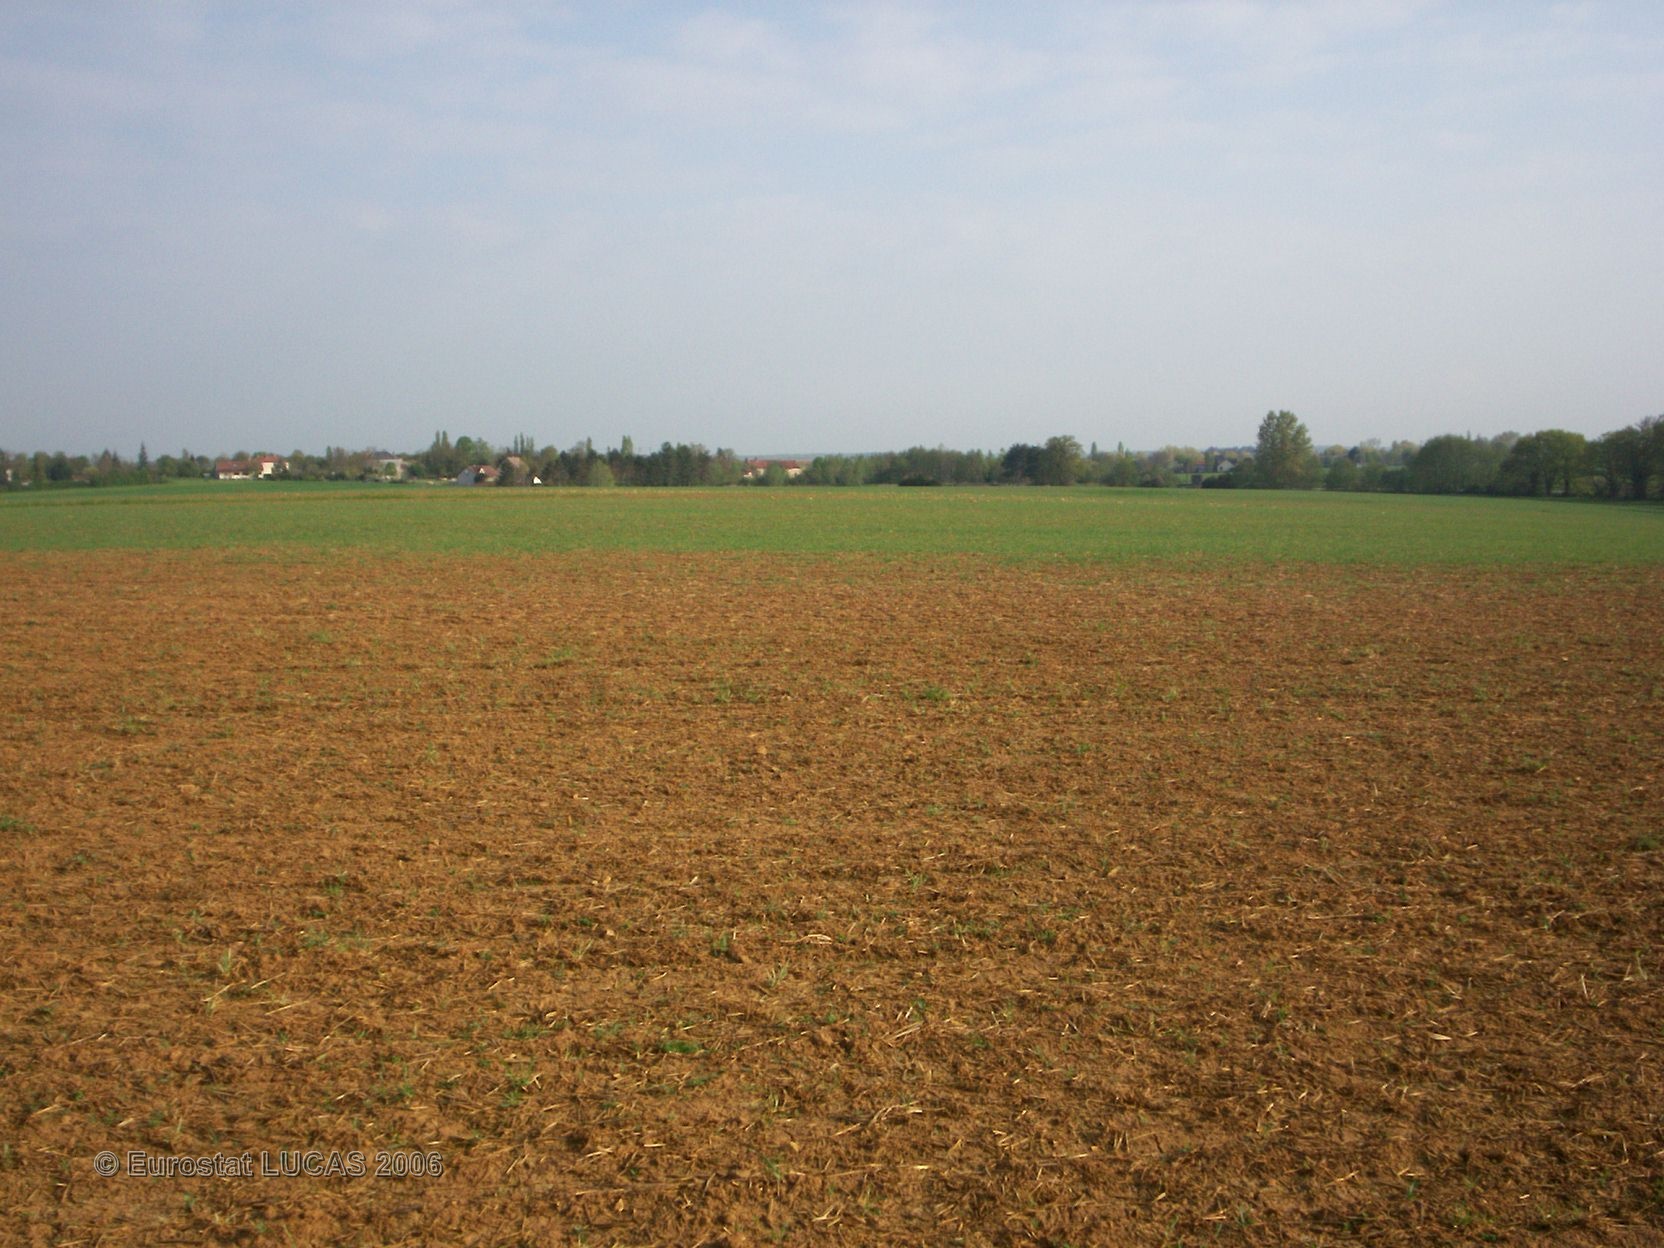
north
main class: Cropland
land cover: Barley
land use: Agriculture (excluding fallow land and kitchen gardens)
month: April
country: FR
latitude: 47.1923
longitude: 3.0662
